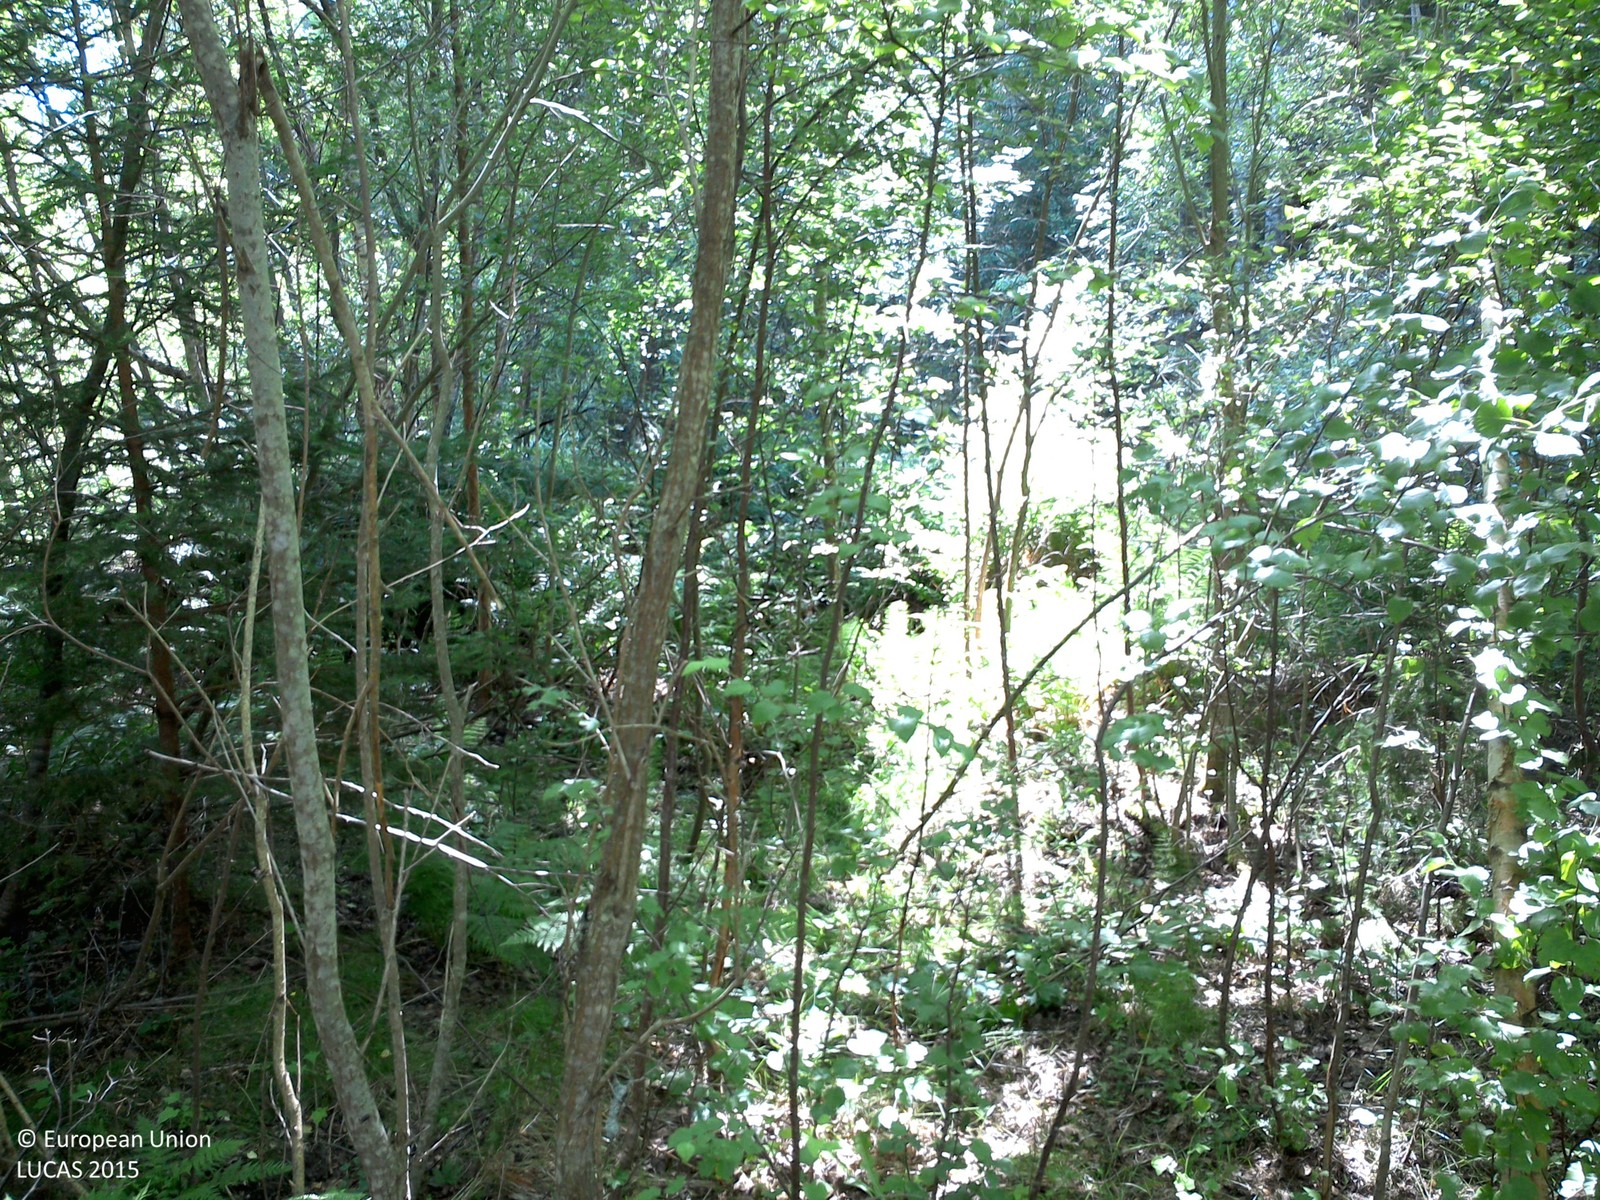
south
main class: Woodland
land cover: Broadleaved woodland
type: boreal forest
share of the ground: > 75 %
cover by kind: broadleaved forest trees 80 %, herbaceous plants 20 %
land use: Forestry
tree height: > 5 m
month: July
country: SE
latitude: 58.1039
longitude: 14.6268
